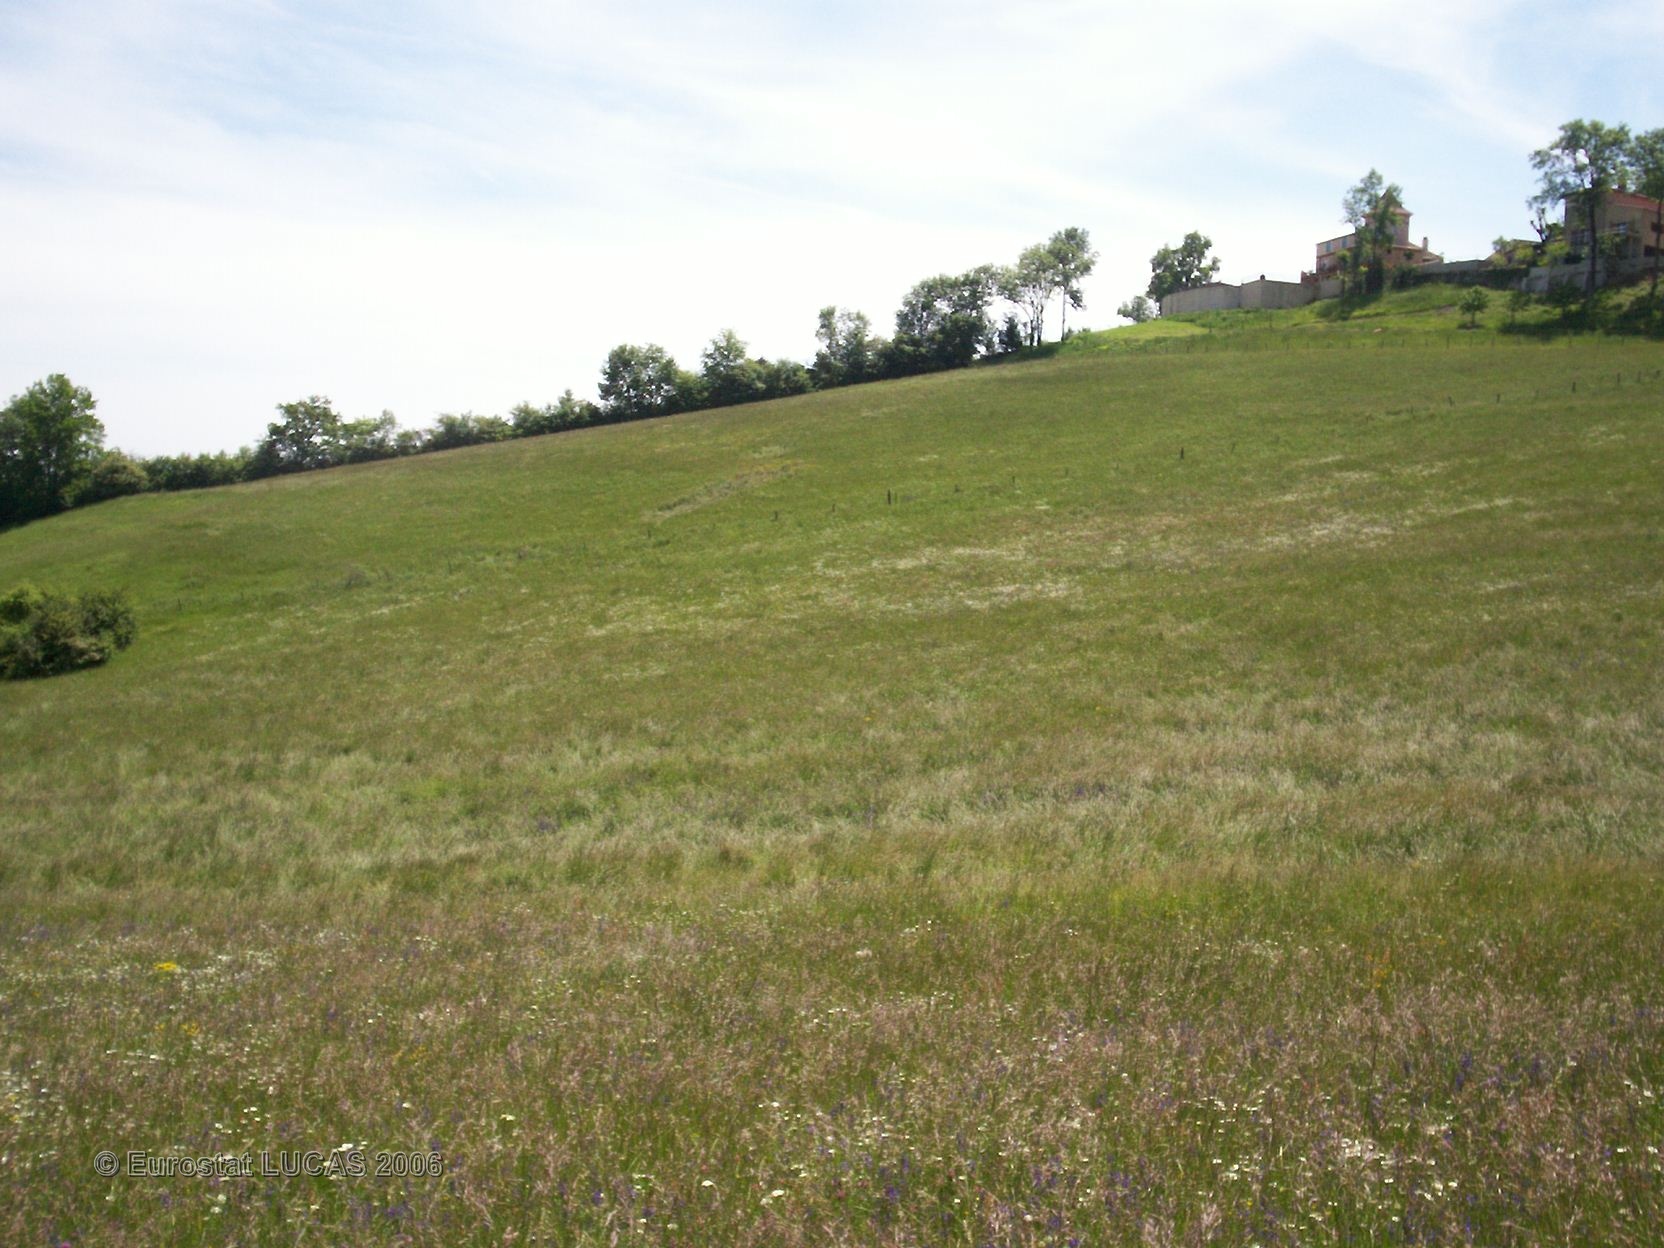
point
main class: Grassland
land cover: Grassland without tree/shrub cover
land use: Agriculture (excluding fallow land and kitchen gardens)
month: May
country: FR
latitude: 44.0934
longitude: 1.9710
